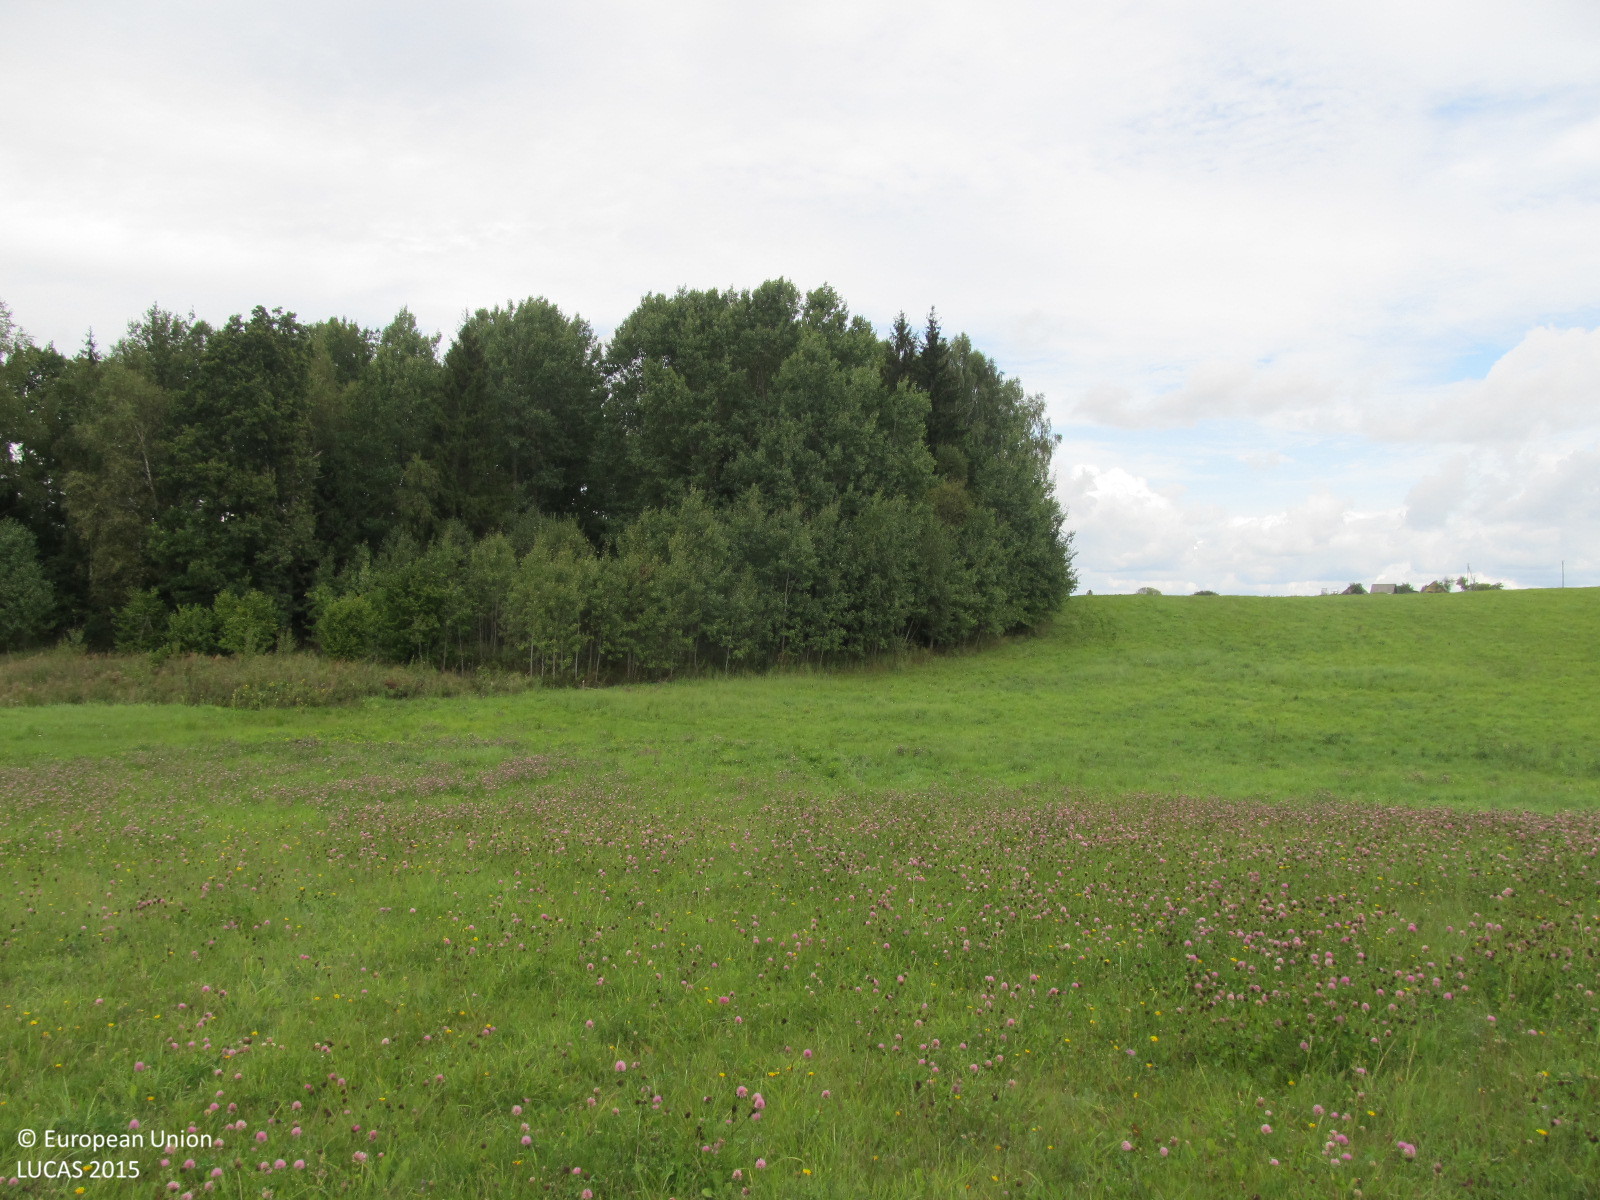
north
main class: Grassland
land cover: Grassland without tree/shrub cover
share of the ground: > 75 %
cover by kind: herbaceous plants 100 %
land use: Agriculture (excluding fallow land and kitchen gardens)
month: September
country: LT
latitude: 55.6545
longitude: 22.6018
